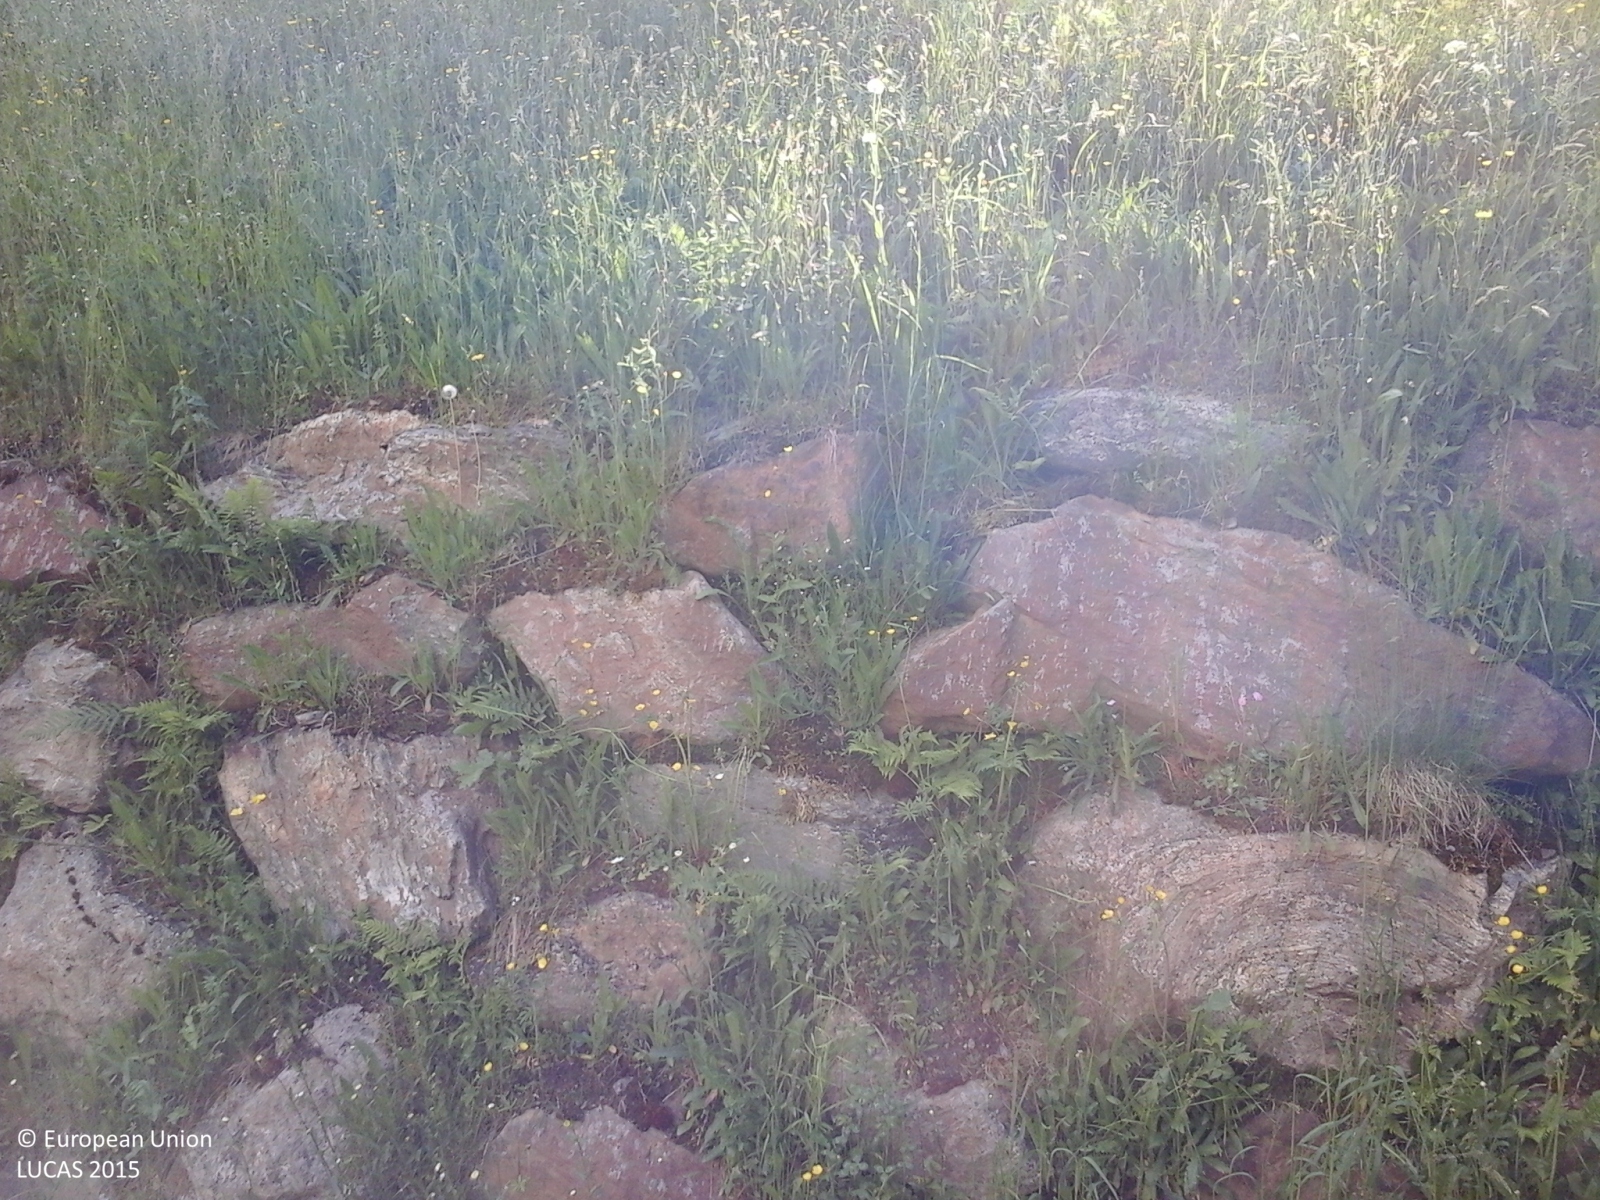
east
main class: Woodland
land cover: Spruce dominated mixed woodland
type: alpine coniferous forest
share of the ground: > 75 %
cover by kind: coniferous forest trees 70 %, broadleaved forest trees 30 %
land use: Forestry
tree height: > 5 m
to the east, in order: Spruce dominated mixed woodland; Tracks; Dry stone walls; Grassland without tree/shrub cover; Tracks; Spruce dominated mixed woodland
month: May
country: IT
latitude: 46.5622
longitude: 11.0554
